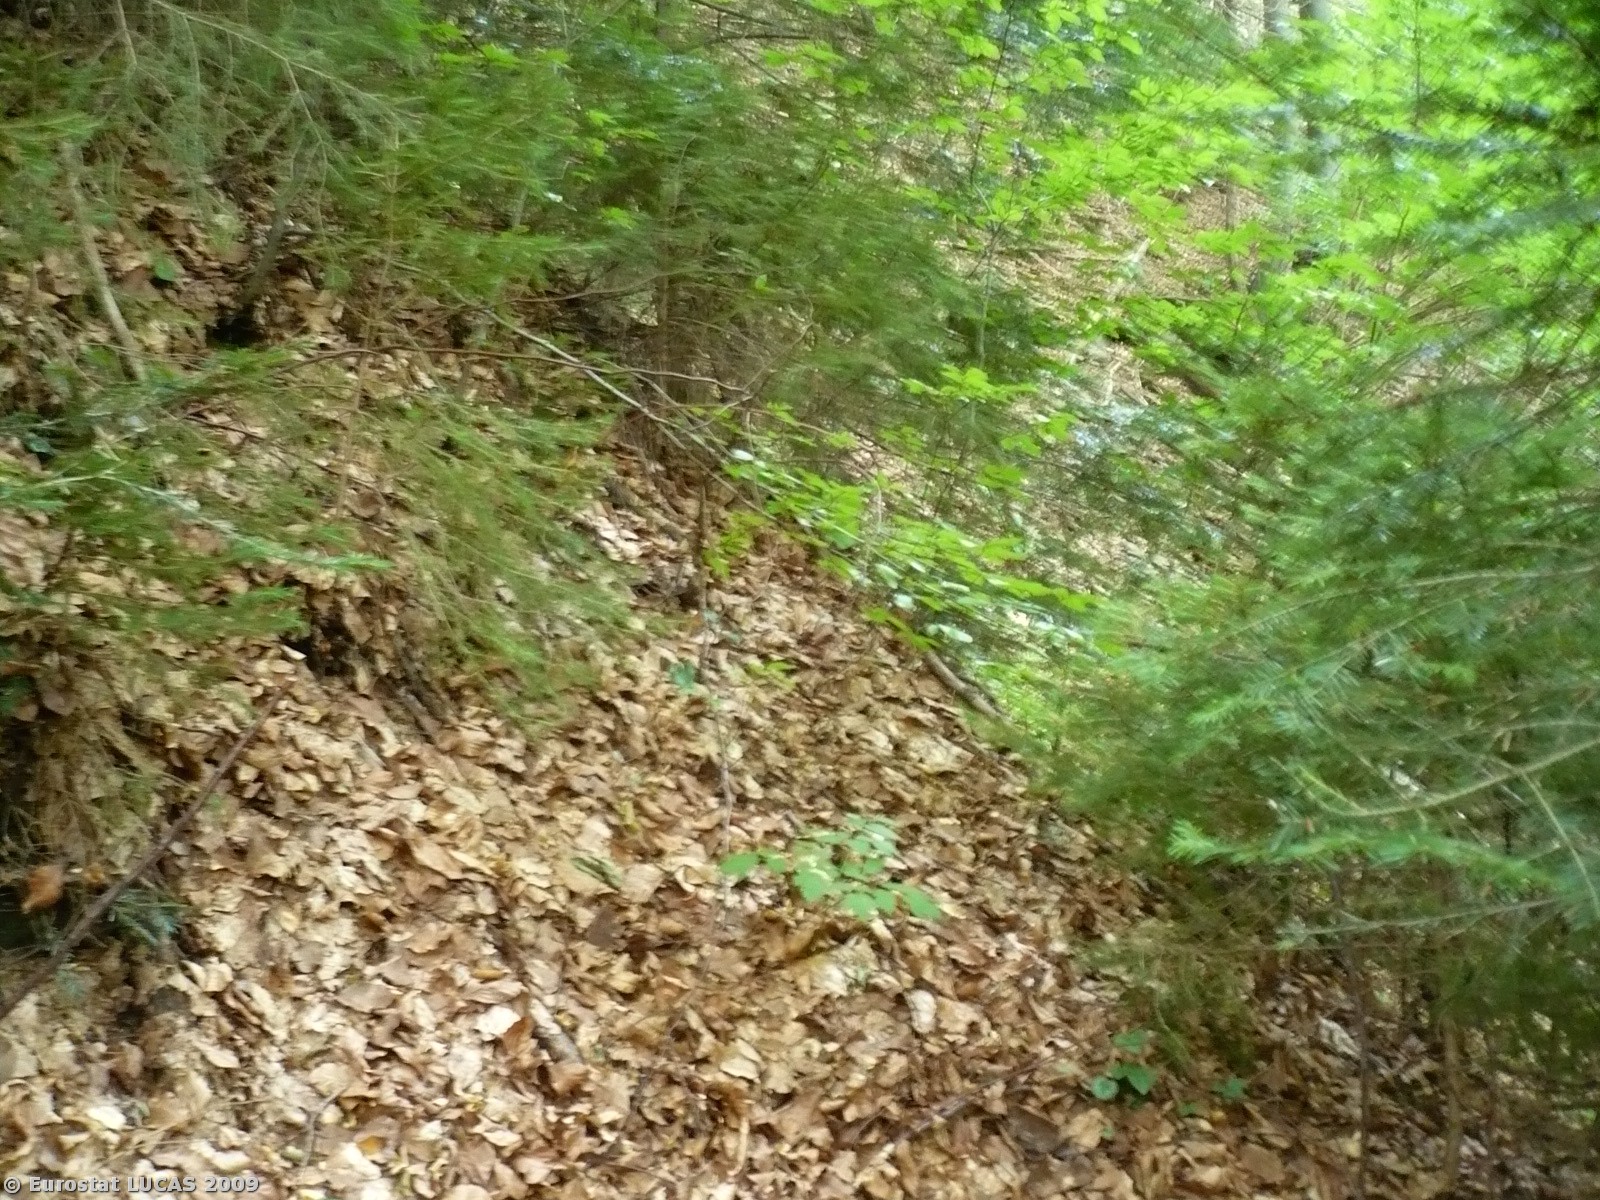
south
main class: Woodland
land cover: Mixed woodland
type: beech forest
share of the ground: > 75 %
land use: Forestry
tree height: > 5 m
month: August
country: SI
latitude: 46.3058
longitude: 15.3864
